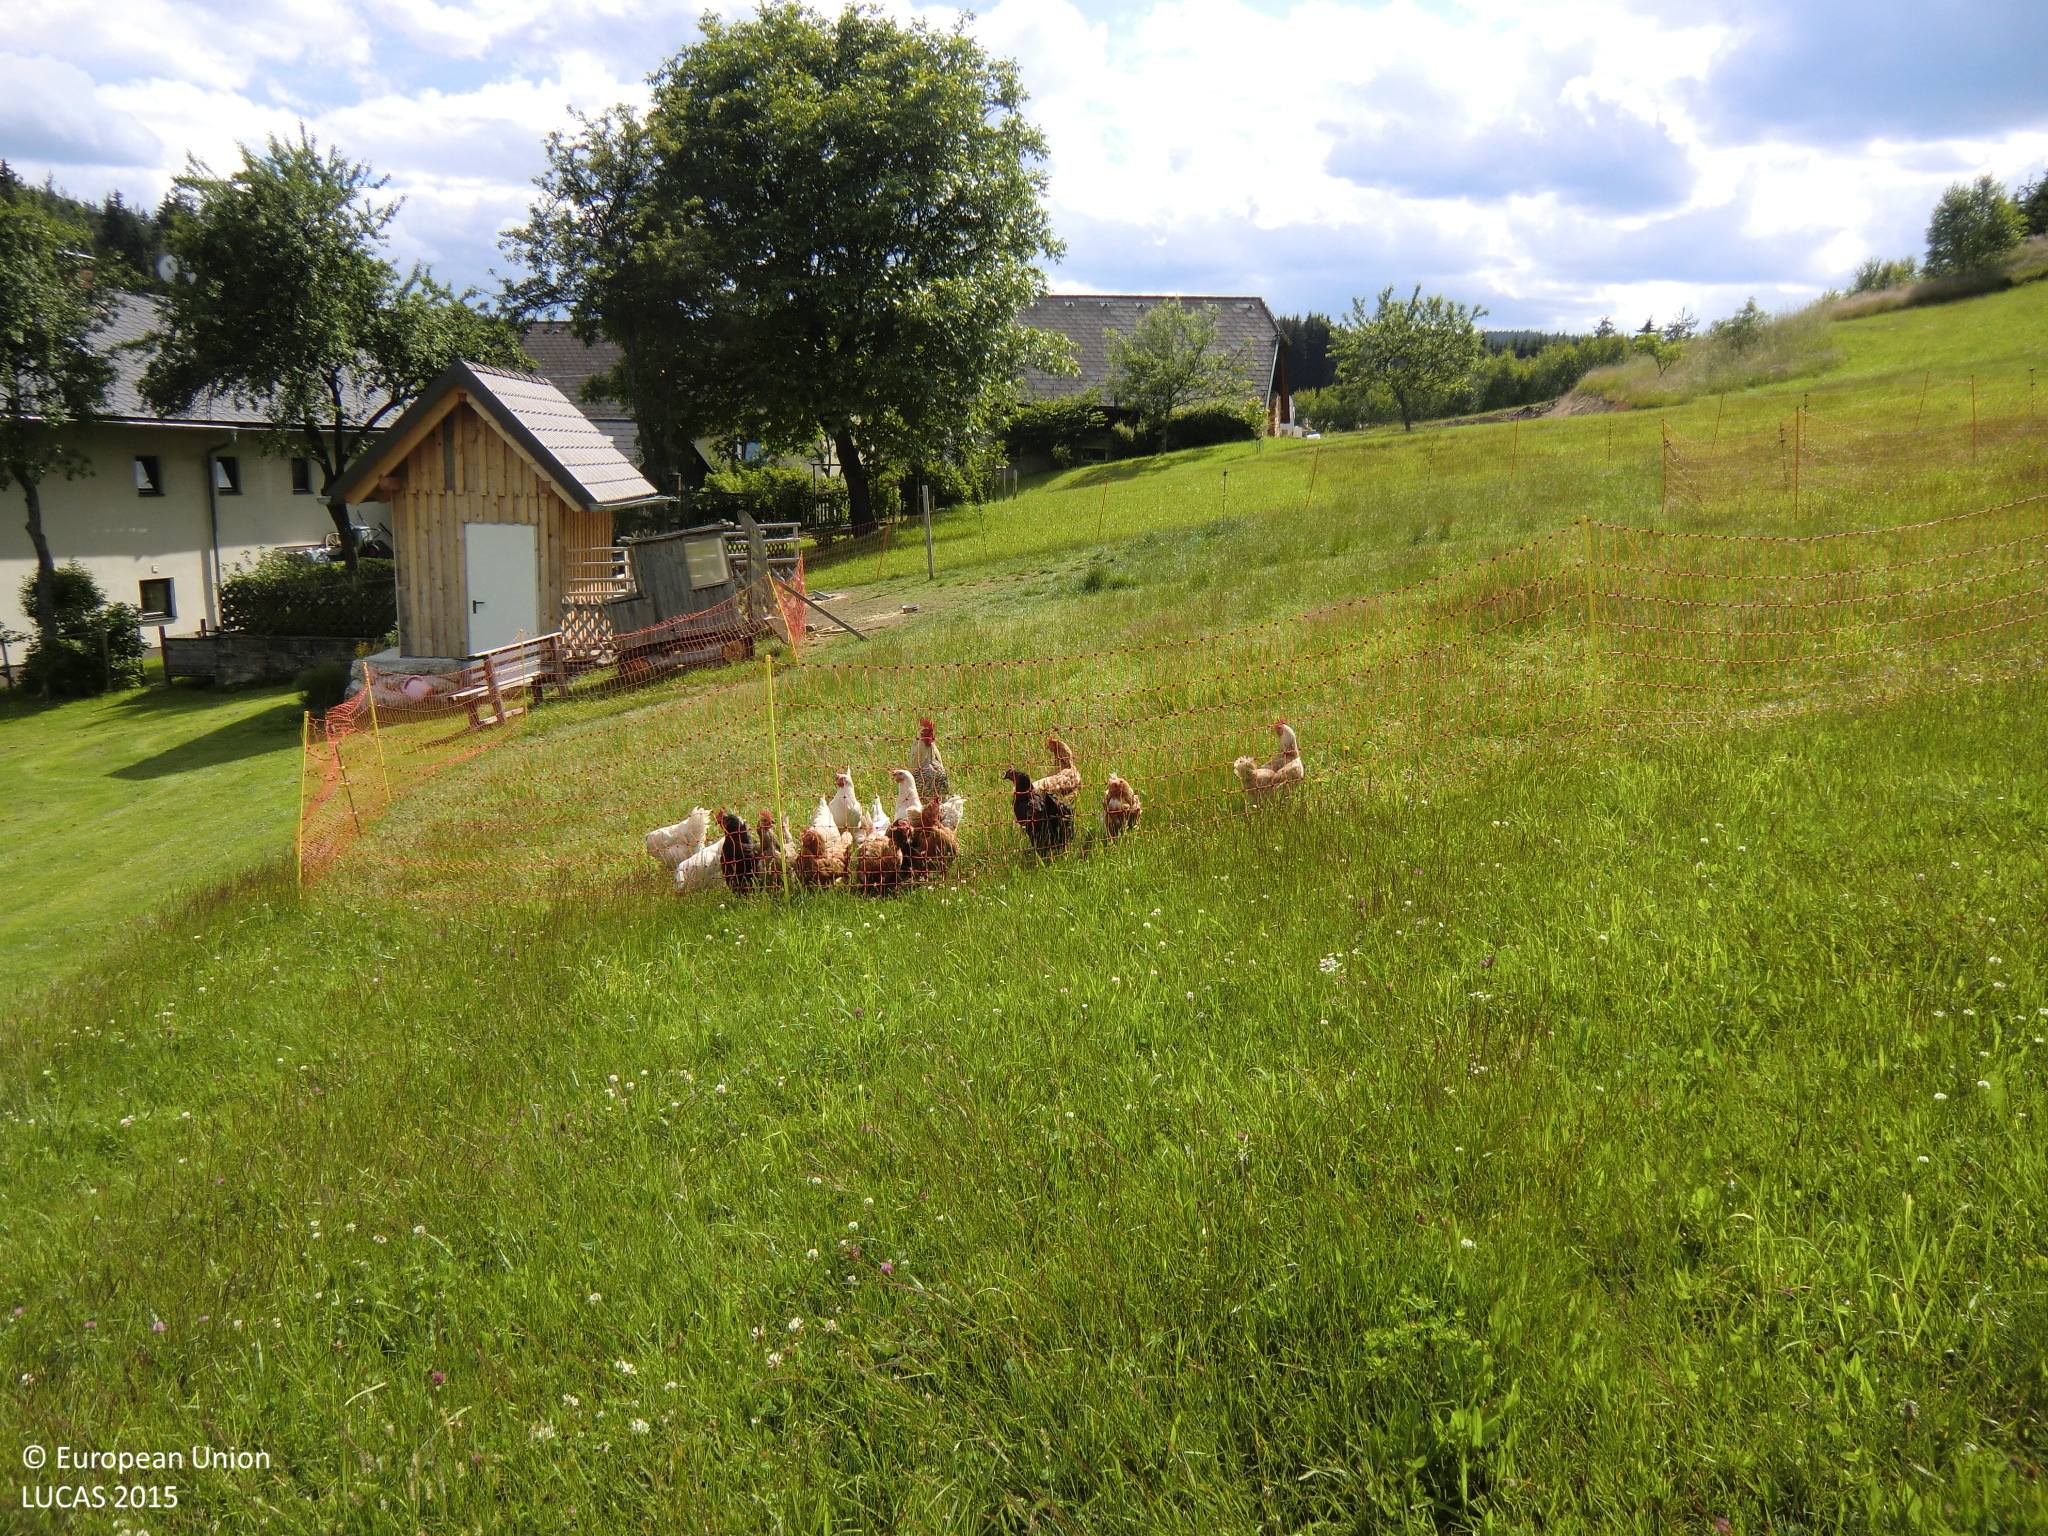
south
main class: Grassland
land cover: Grassland without tree/shrub cover
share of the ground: > 75 %
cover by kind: herbaceous plants 95 %, unconsolidated bare surface 5 %
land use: Agriculture (excluding fallow land and kitchen gardens)
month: June
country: AT
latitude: 48.5668
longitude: 14.8664
